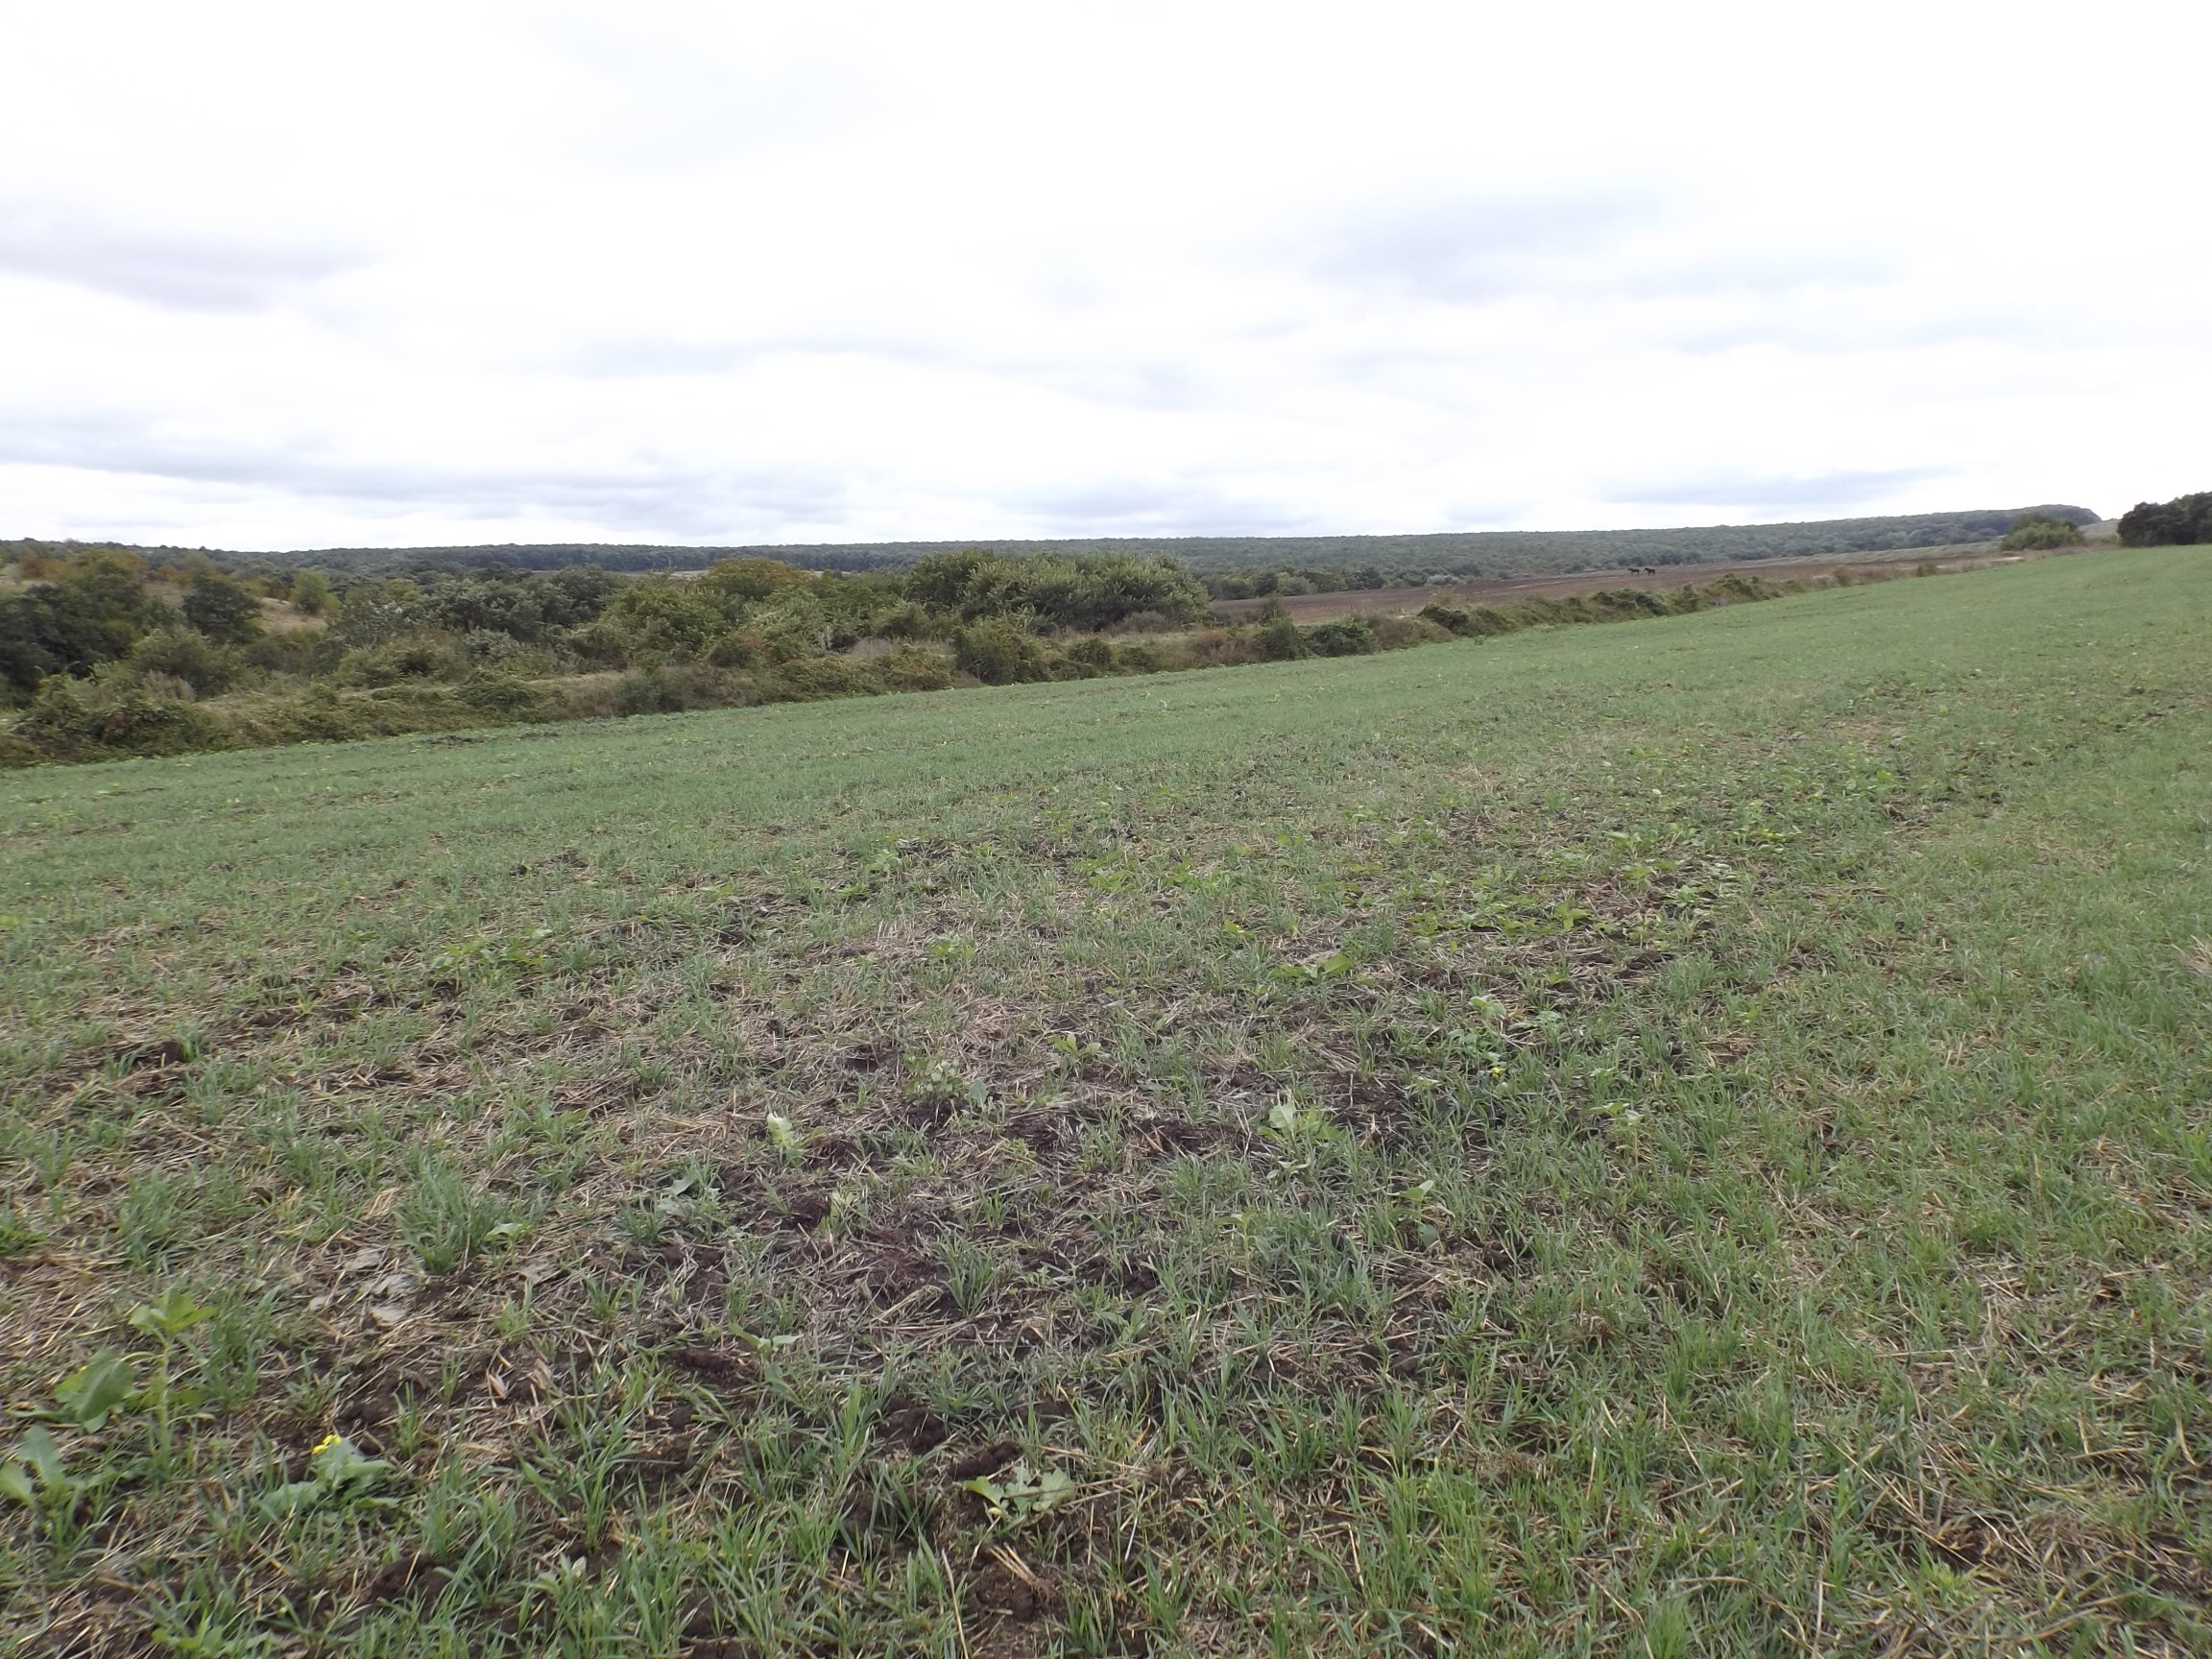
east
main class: Cropland
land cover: Common wheat
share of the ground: < 10 %
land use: Agriculture (excluding fallow land and kitchen gardens)
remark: Harvested field
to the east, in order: Common wheat; Grass margins; Paved roads, cycling and walking lanes; Grass margins; Common wheat
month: September
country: BG
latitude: 43.0957
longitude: 27.4600
